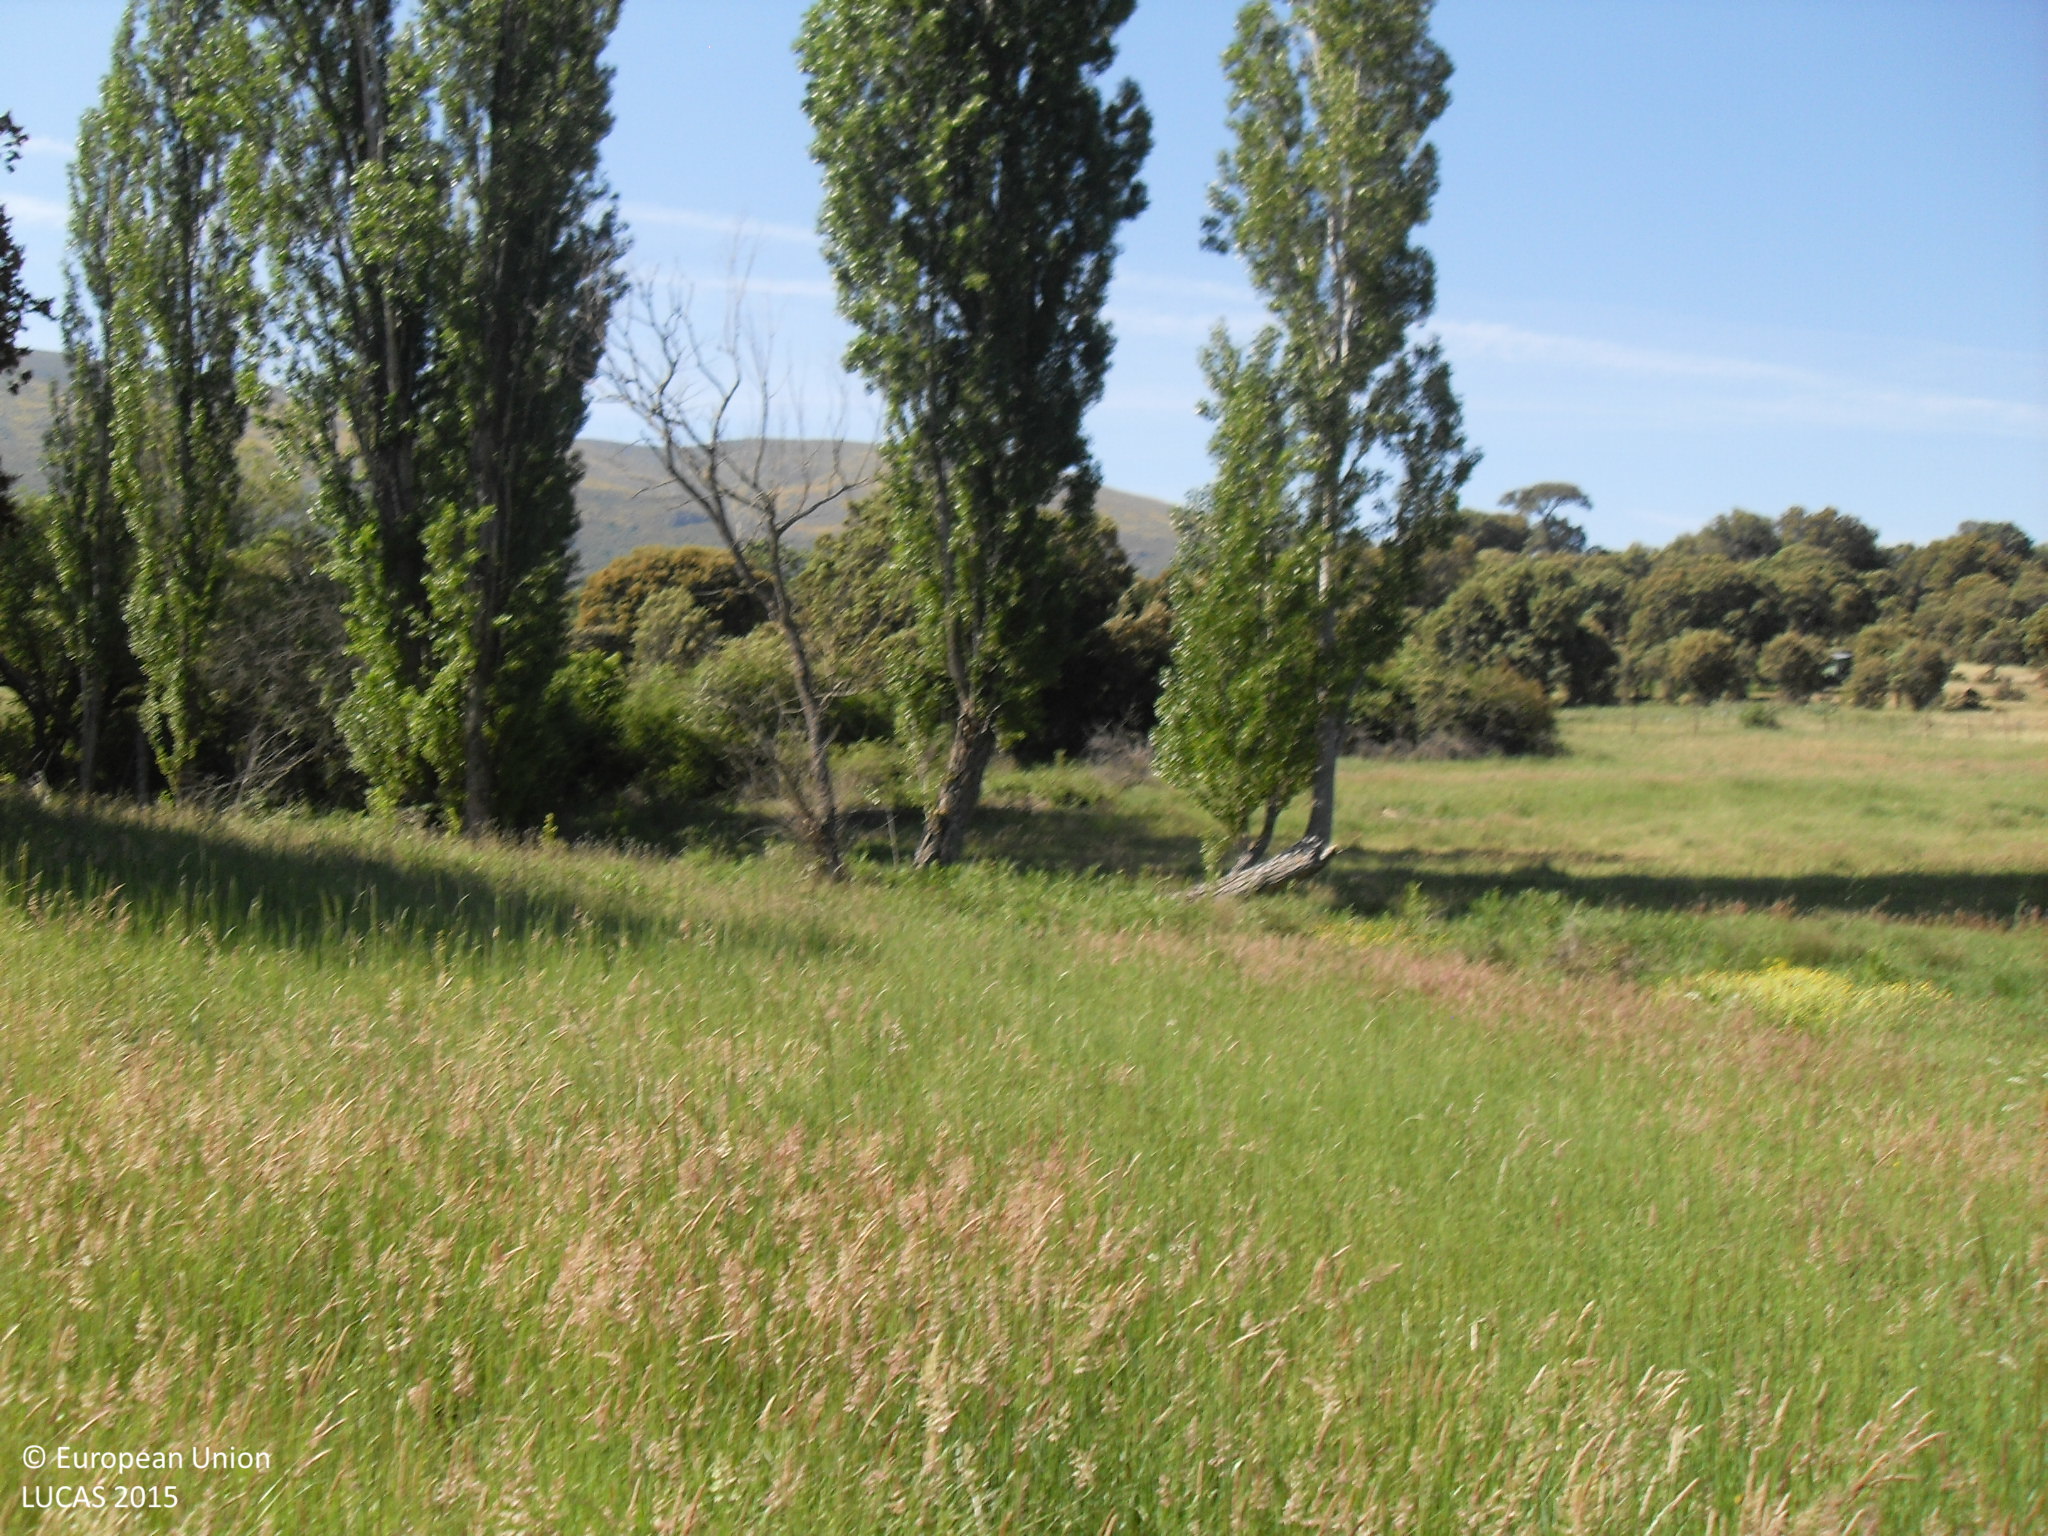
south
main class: Grassland
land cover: Grassland without tree/shrub cover
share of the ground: > 75 %
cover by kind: herbaceous plants 100 %
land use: Agriculture (excluding fallow land and kitchen gardens)
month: May
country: ES
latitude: 40.4967
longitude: -5.2723
